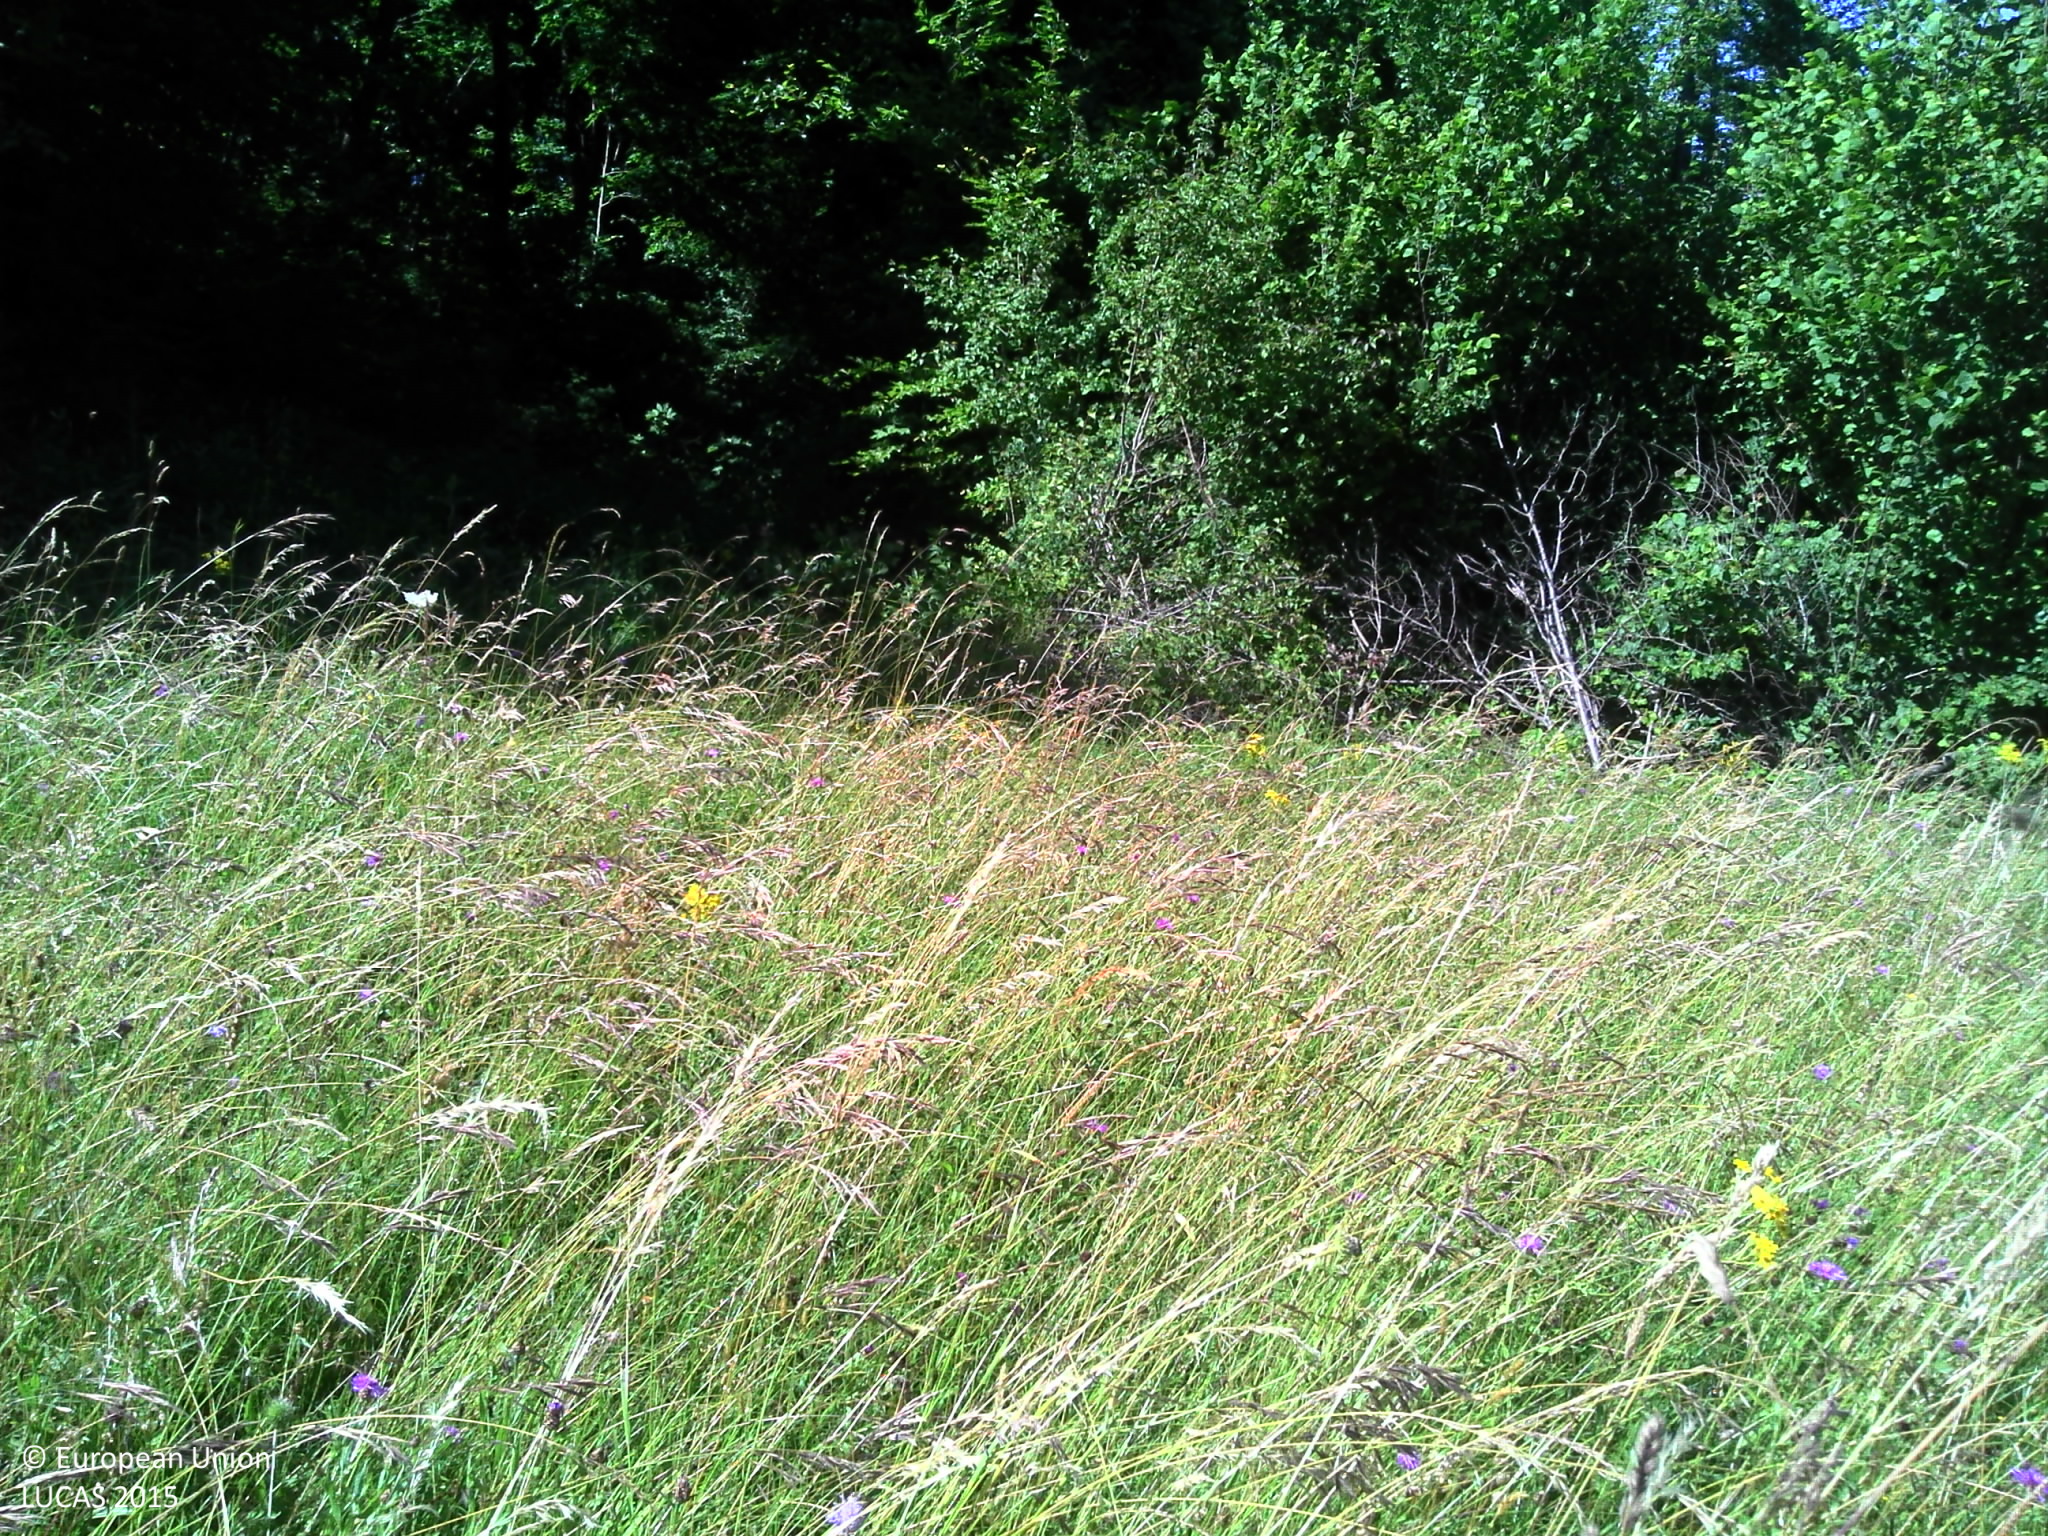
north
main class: Grassland
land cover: Grassland without tree/shrub cover
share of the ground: > 75 %
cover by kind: herbaceous plants 100 %
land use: Agriculture (excluding fallow land and kitchen gardens)
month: June
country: FR
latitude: 46.5812
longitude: 5.5003
